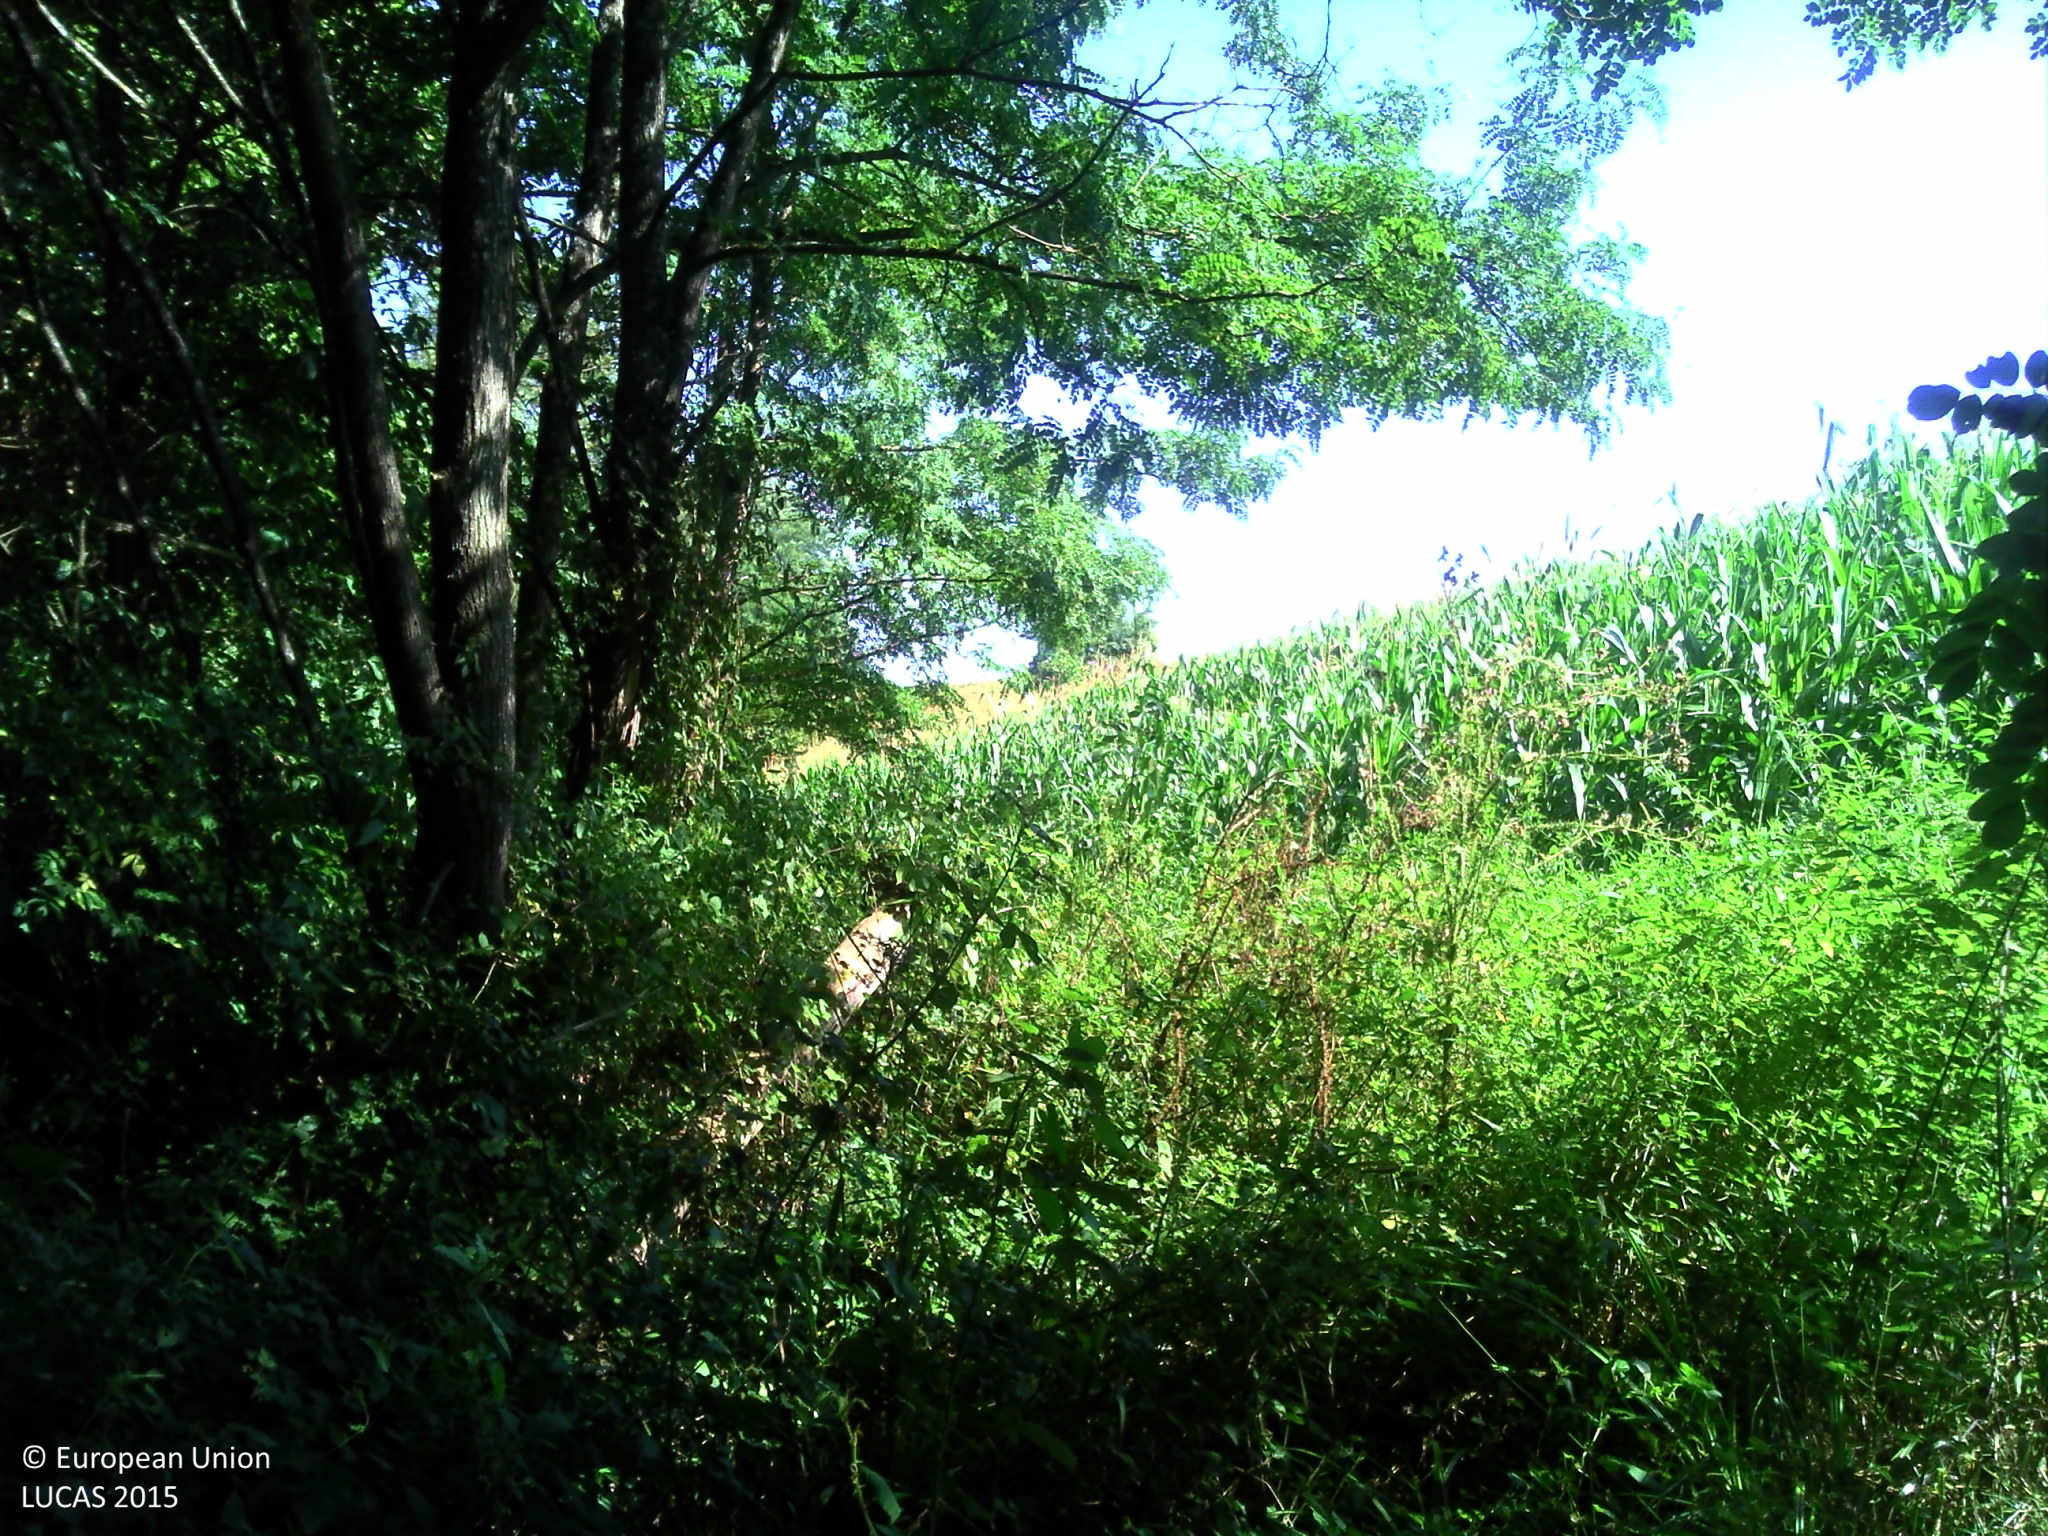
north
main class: Woodland
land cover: Broadleaved woodland
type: thermophilous deciduous forest
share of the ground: > 75 %
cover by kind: broadleaved forest trees 65 %, shrubs 20 %, herbaceous plants 10 %, lichens and mosses 5 %
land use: Forestry
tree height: > 5 m
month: August
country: FR
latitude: 43.4771
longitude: -1.1289
